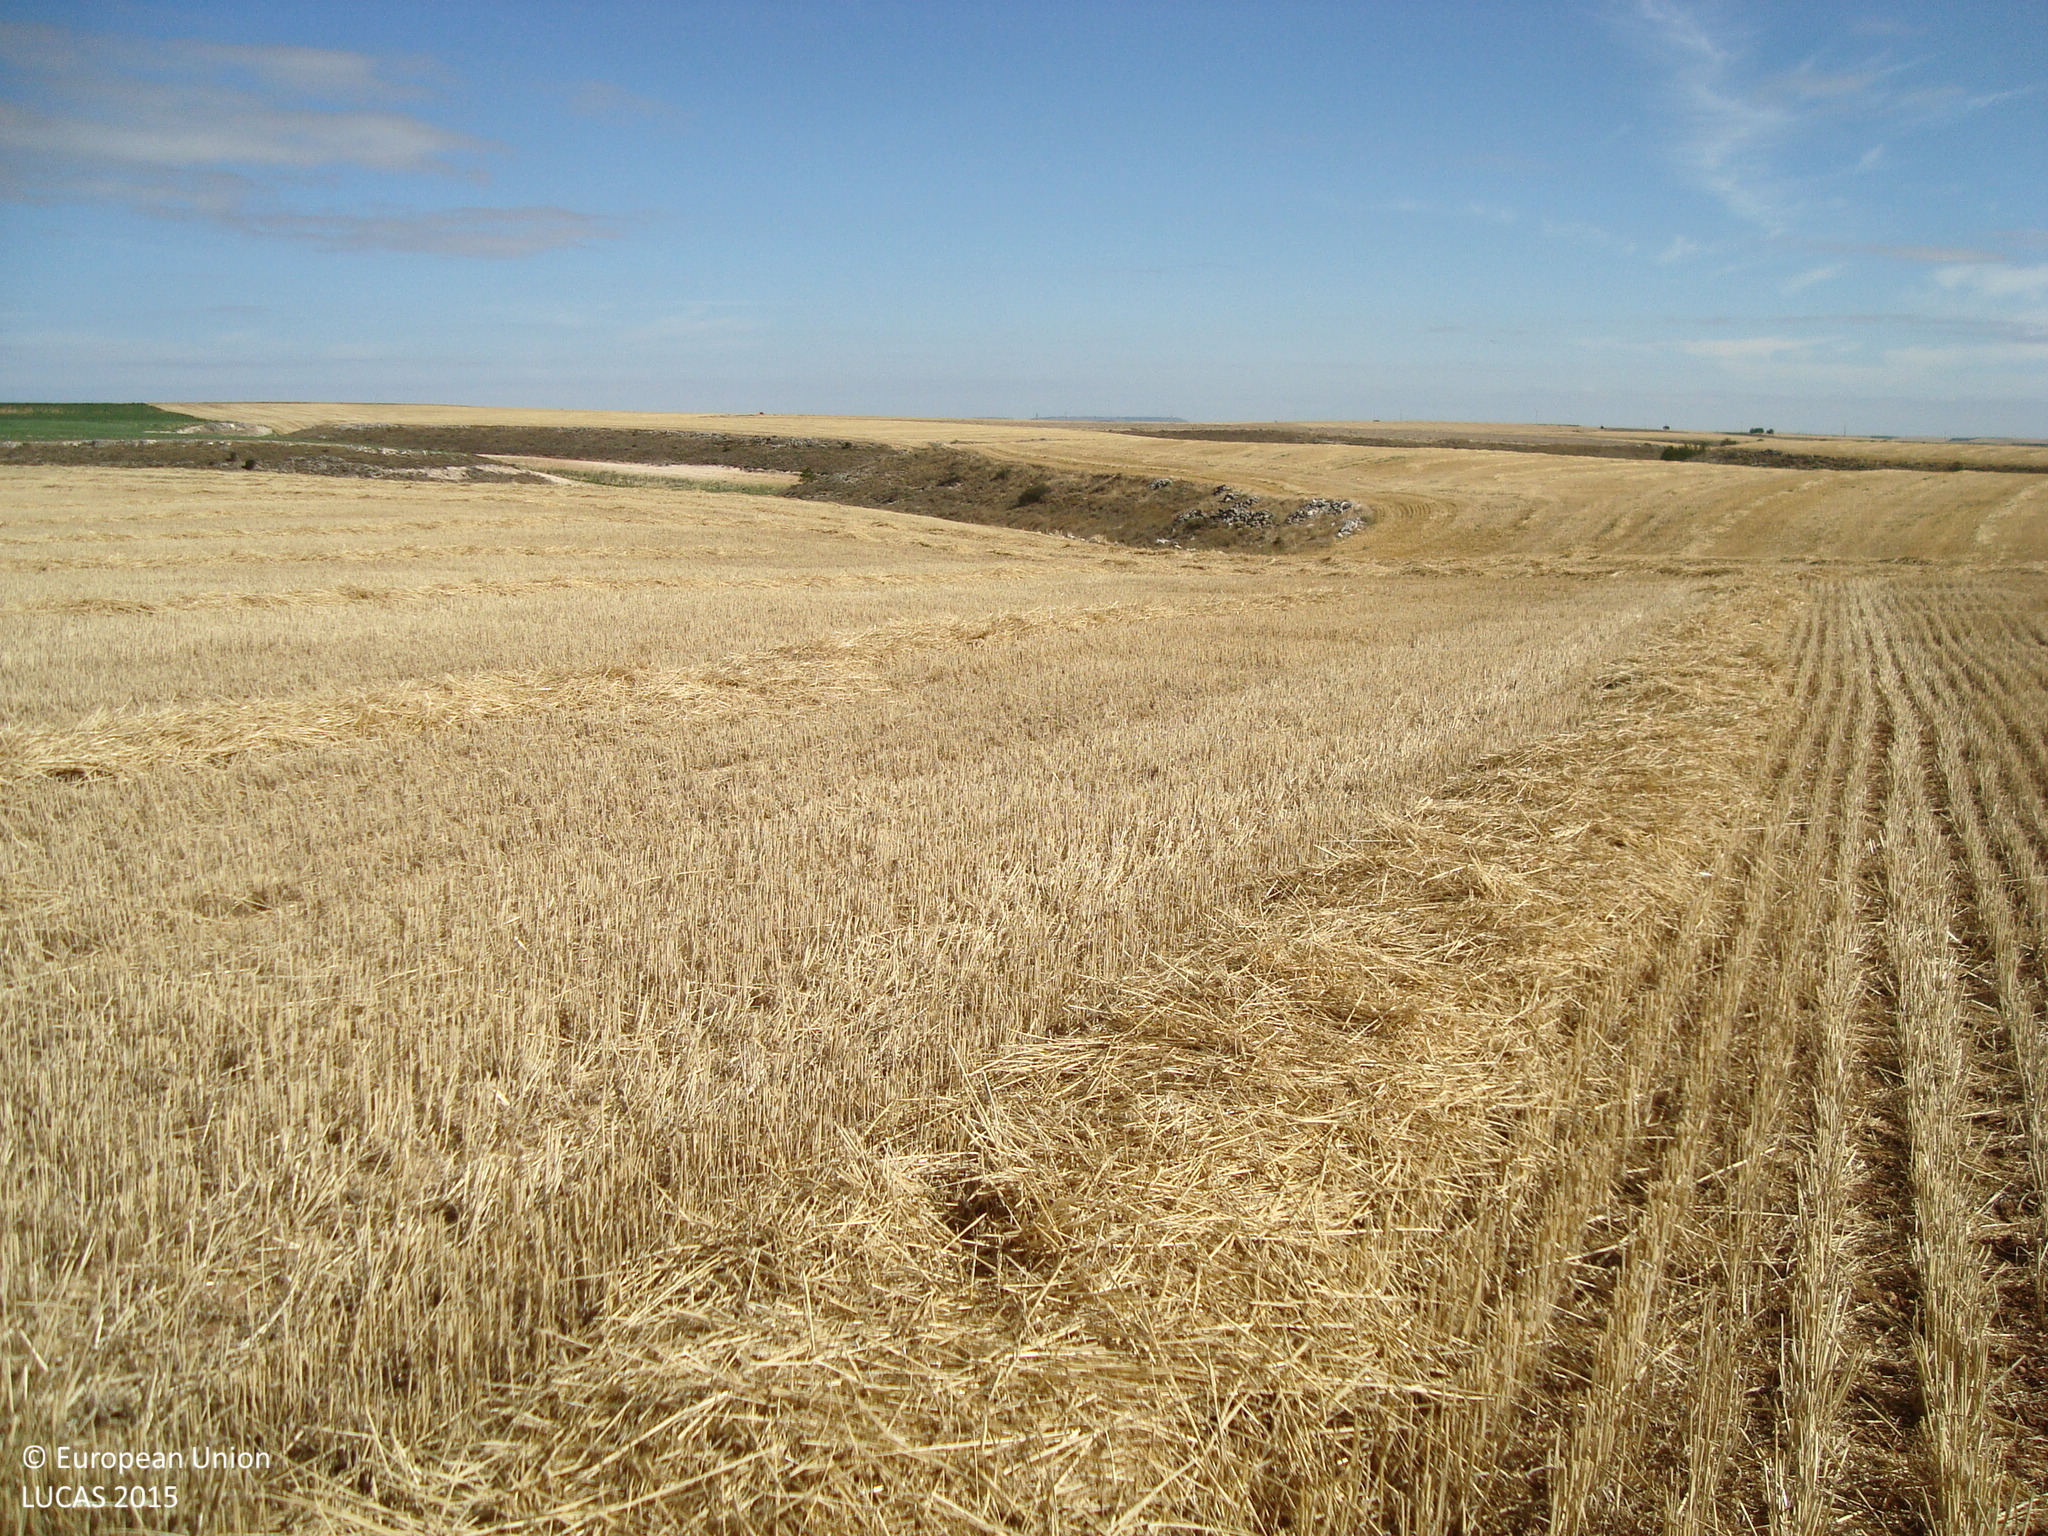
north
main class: Cropland
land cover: Common wheat
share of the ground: > 75 %
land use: Agriculture (excluding fallow land and kitchen gardens)
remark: Harvested field
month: July
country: ES
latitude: 41.9860
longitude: -3.8796
